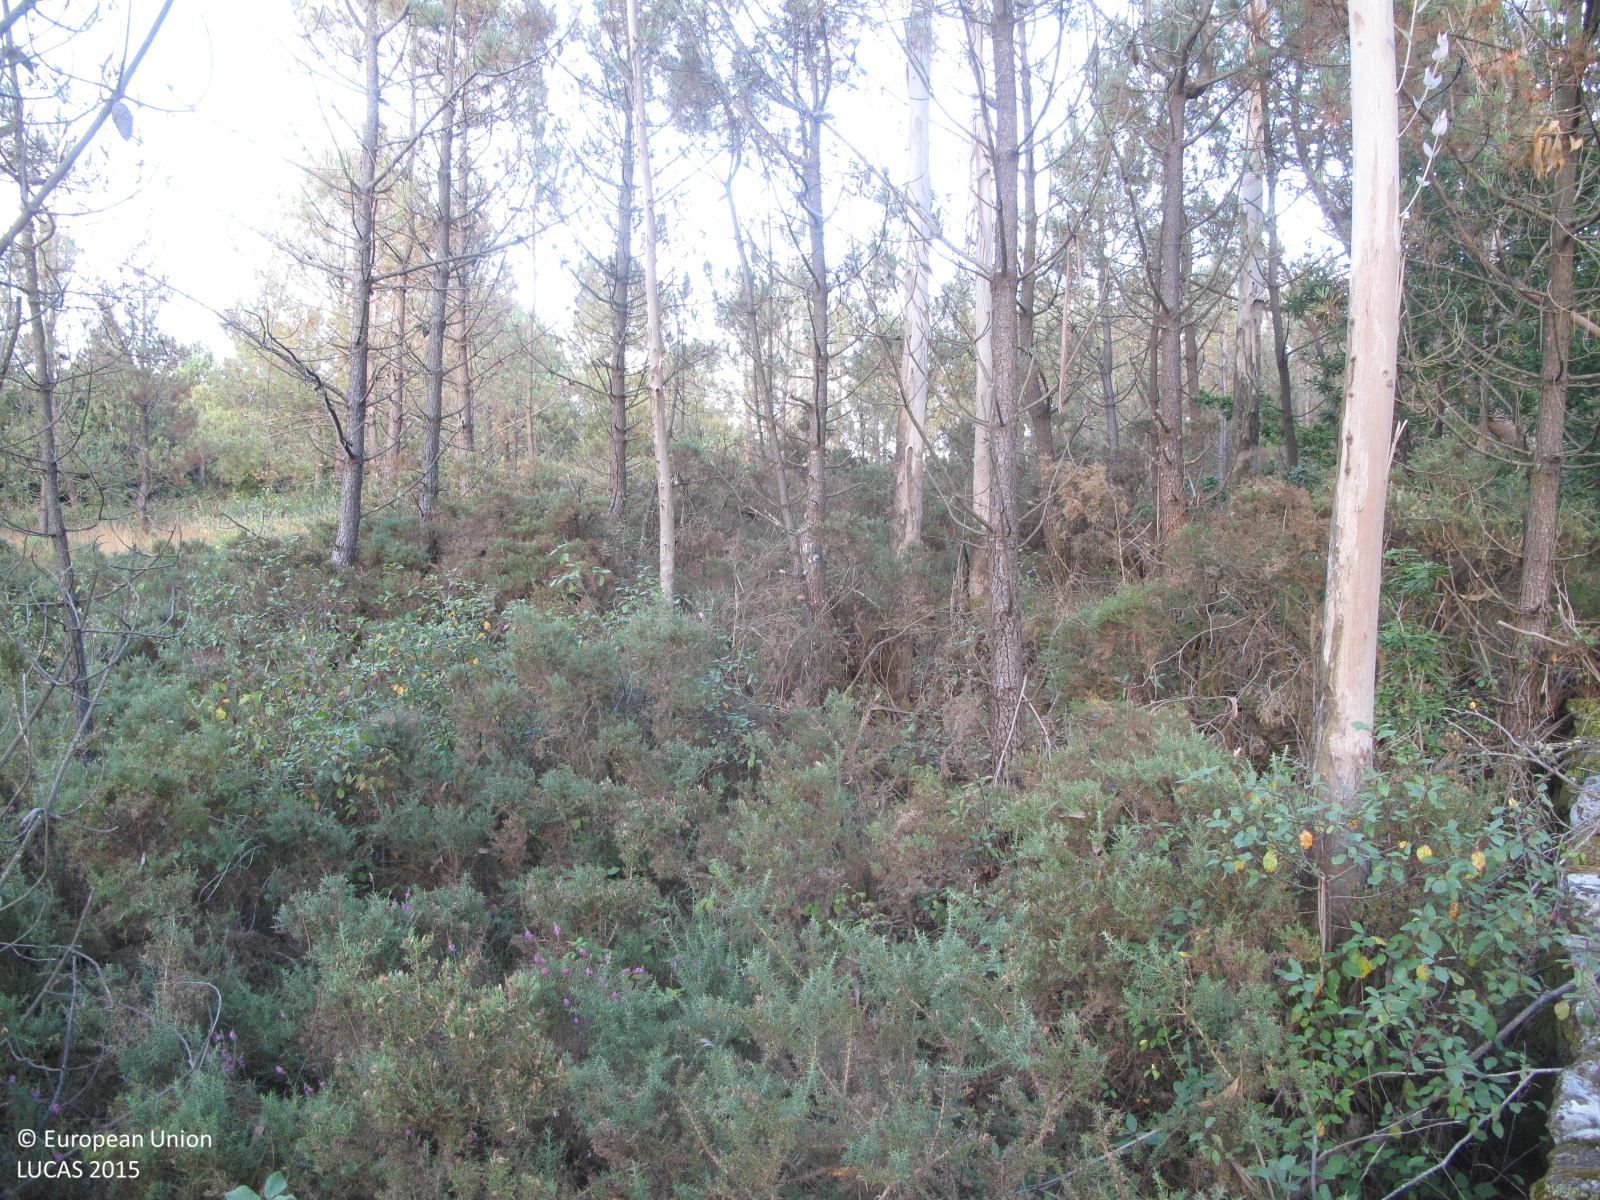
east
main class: Woodland
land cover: Pine dominated coniferous woodland
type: hemiboreal forest and nemoral coniferous forest and mixed broadleaved-coniferous forest
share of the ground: 25 - 50 %
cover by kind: shrubs 50 %, coniferous forest trees 40 %, broadleaved forest trees 5 %, herbaceous plants 5 %
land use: Forestry
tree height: > 5 m
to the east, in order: Pine dominated coniferous woodland; Dry stone walls; Pine dominated coniferous woodland; Shrubland with sparse tree cover; Dry stone walls; Shrubland with sparse tree cover; Pine dominated coniferous woodland; Pine dominated mixed woodland
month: July
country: ES
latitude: 42.9950
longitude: -9.1249
